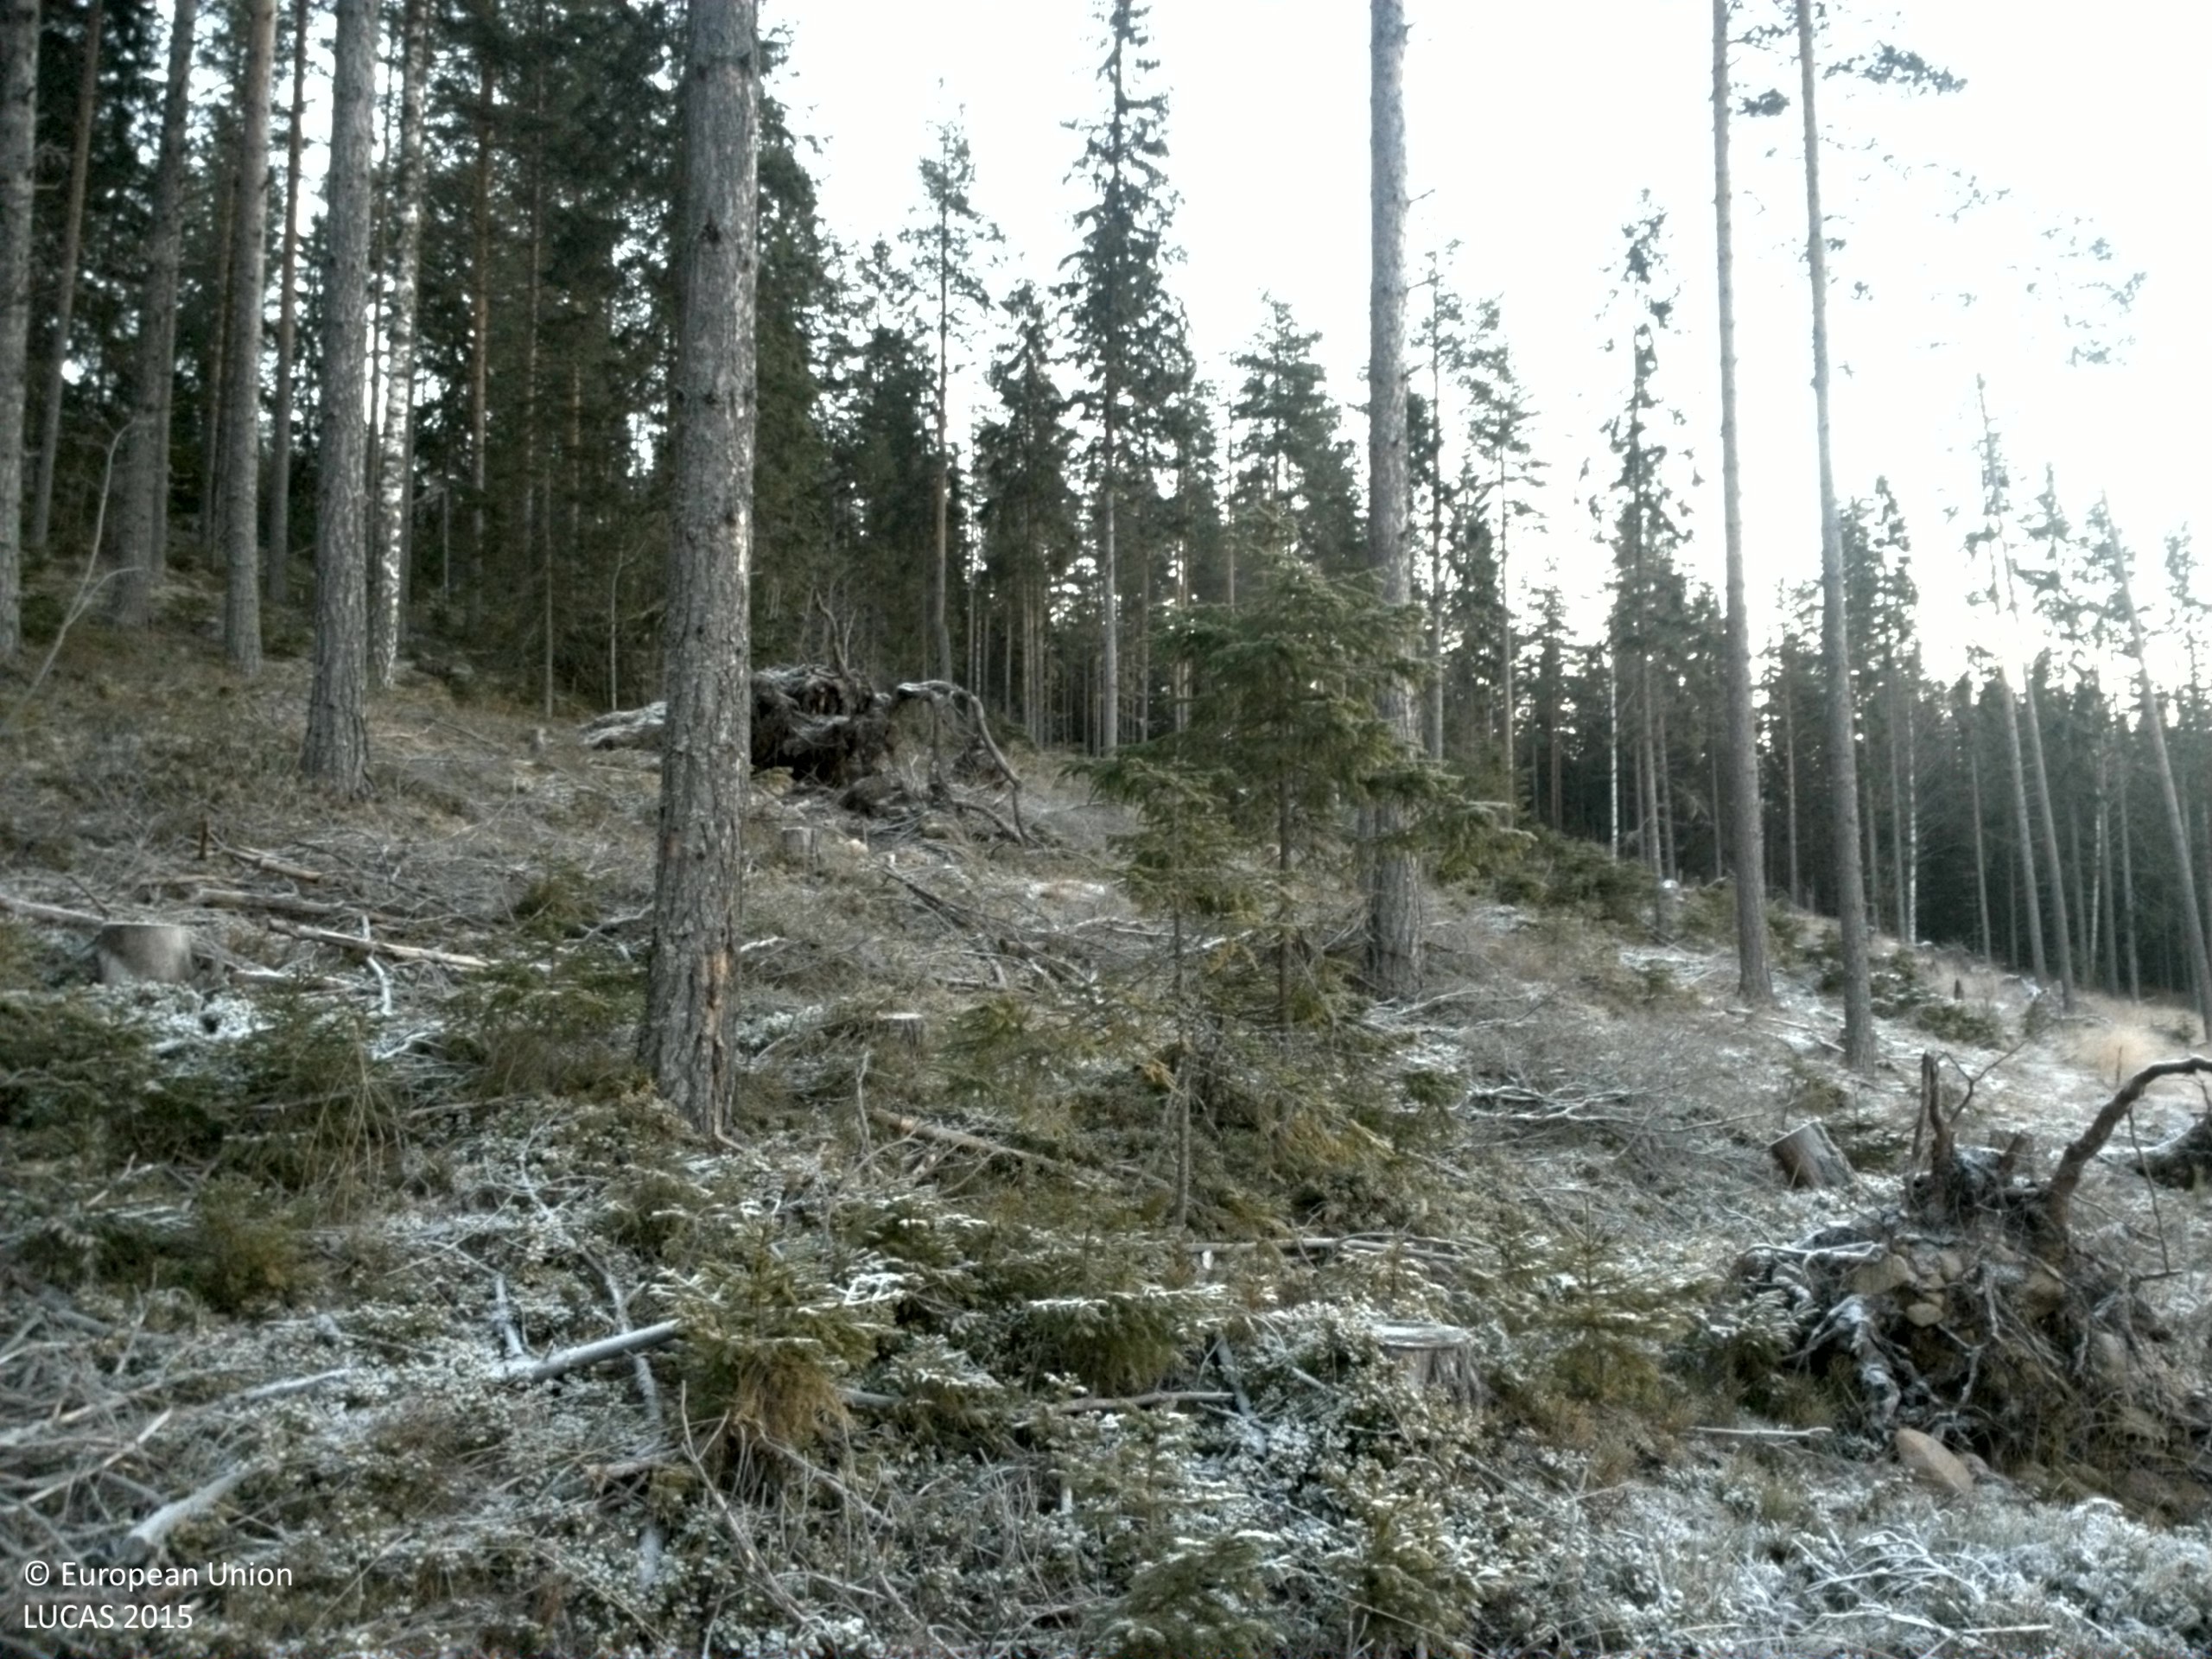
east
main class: Woodland
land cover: Other mixed woodland
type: boreal forest
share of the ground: 10 - 25 %
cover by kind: herbaceous plants 35 %, shrubs 25 %, lichens and mosses 25 %, coniferous forest trees 10 %, broadleaved forest trees 5 %
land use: Forestry
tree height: < 5 m
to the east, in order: Other mixed woodland; Pine dominated coniferous woodland; Other coniferous woodland; Pine dominated coniferous woodland; Other coniferous woodland
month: November
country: SE
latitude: 61.7394
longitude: 16.2873
